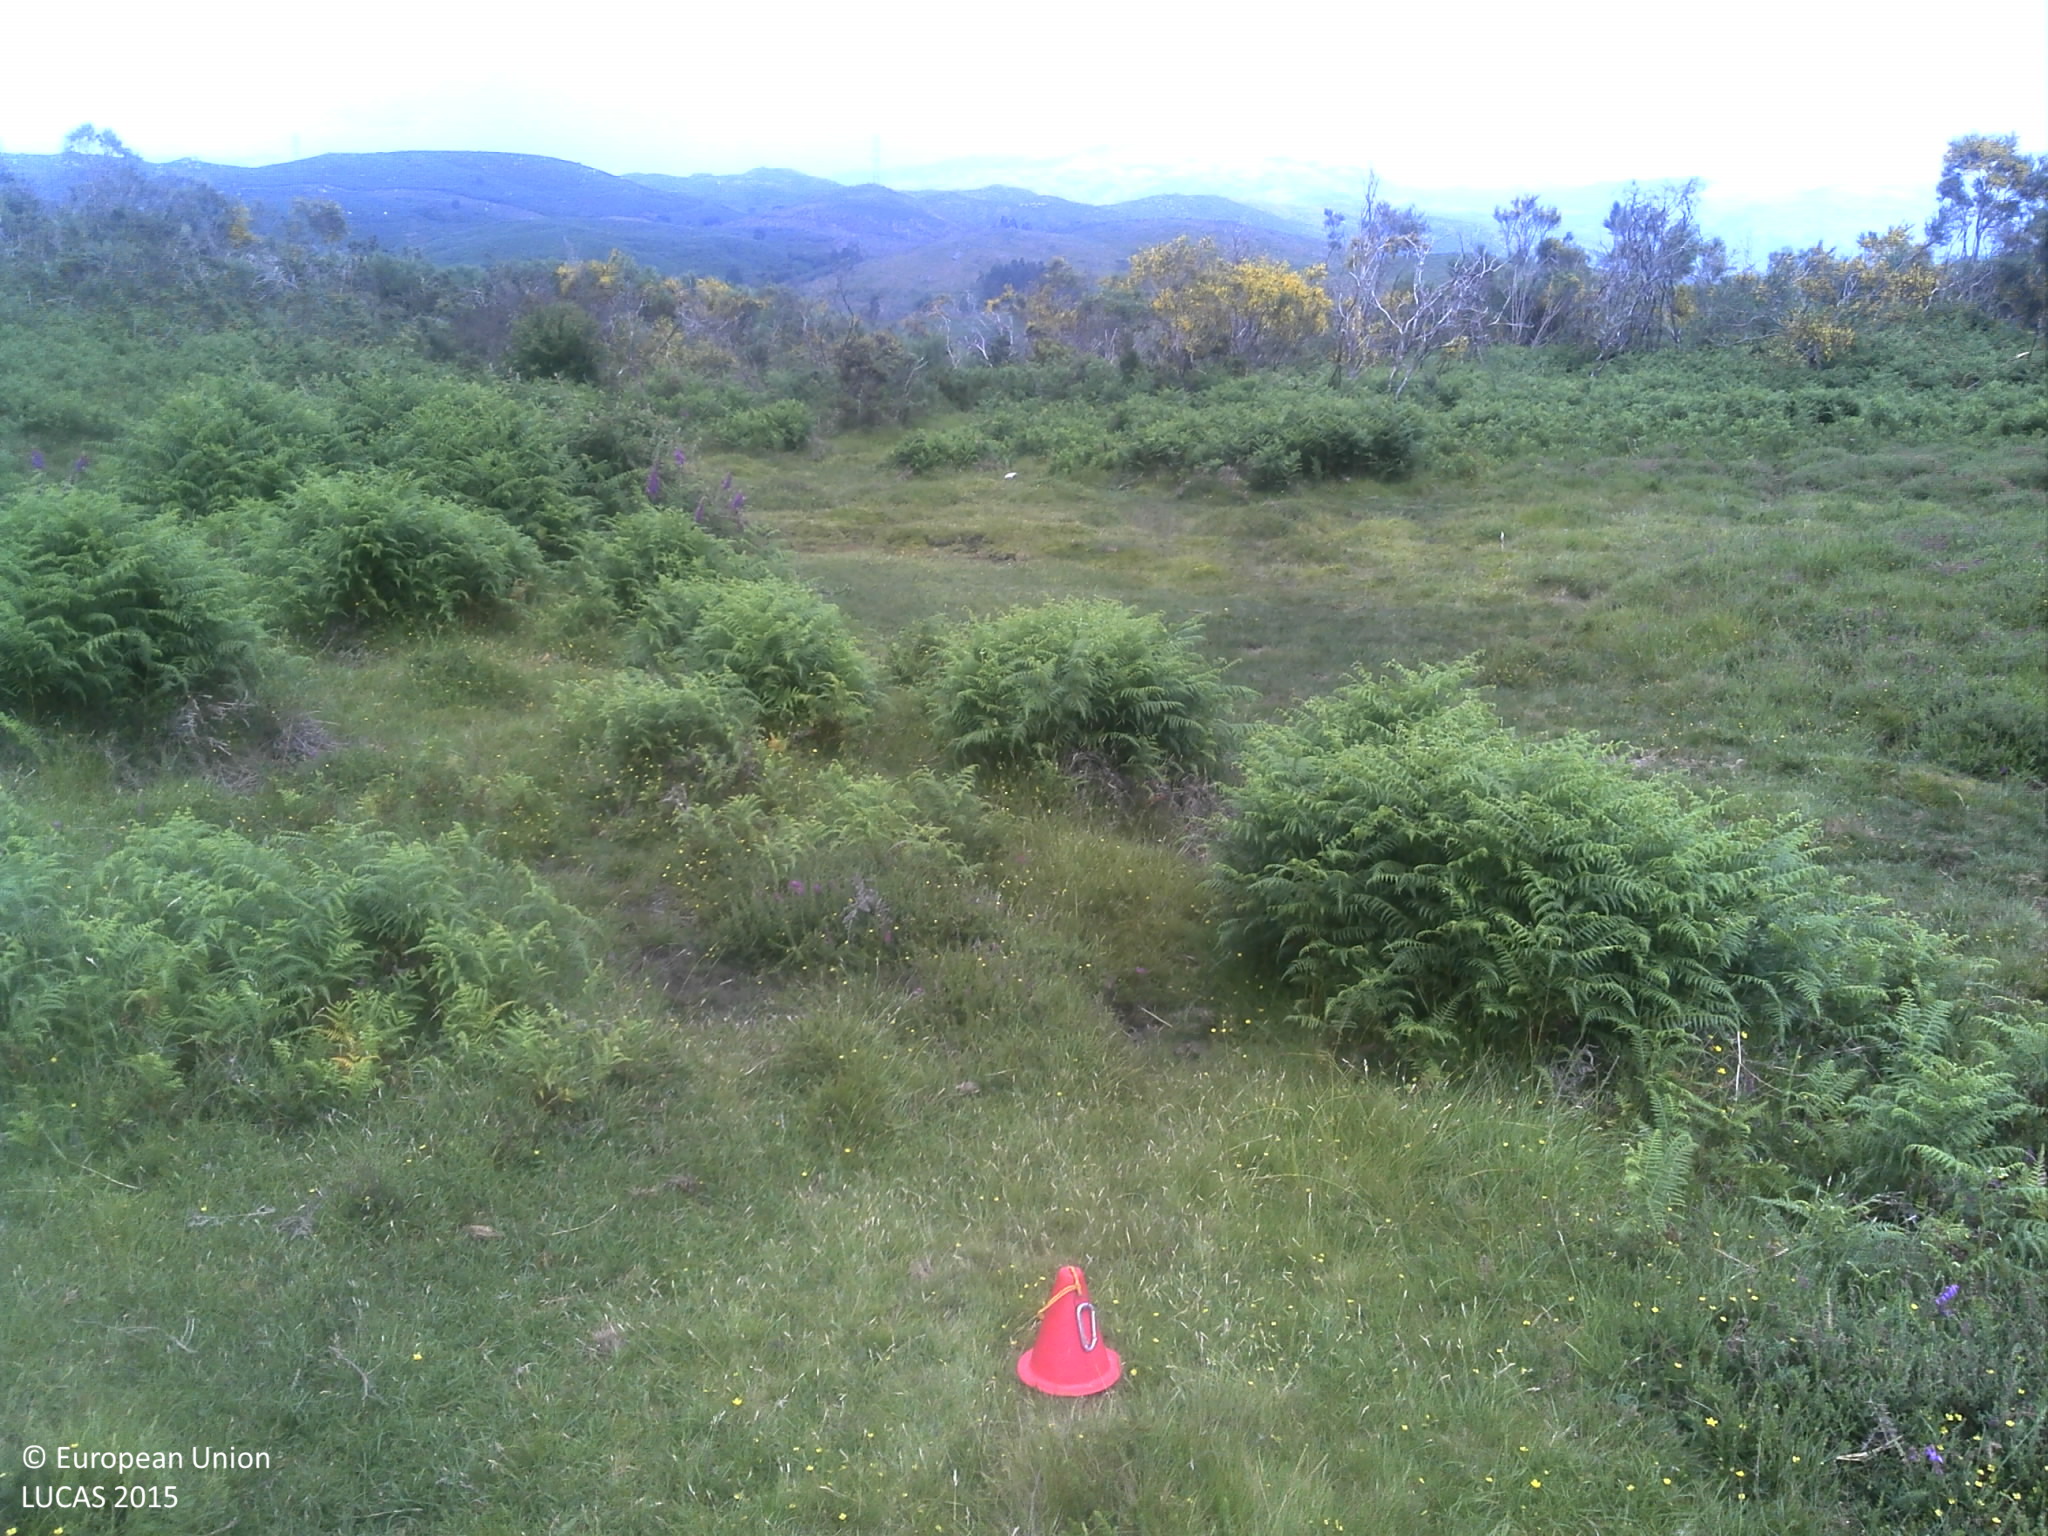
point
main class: Shrubland
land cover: Shrubland without tree cover
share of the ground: > 75 %
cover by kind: shrubs 60 %, herbaceous plants 35 %, unconsolidated bare surface 5 %
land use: Agriculture (excluding fallow land and kitchen gardens)
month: June
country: PT
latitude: 41.7328
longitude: -8.3694
